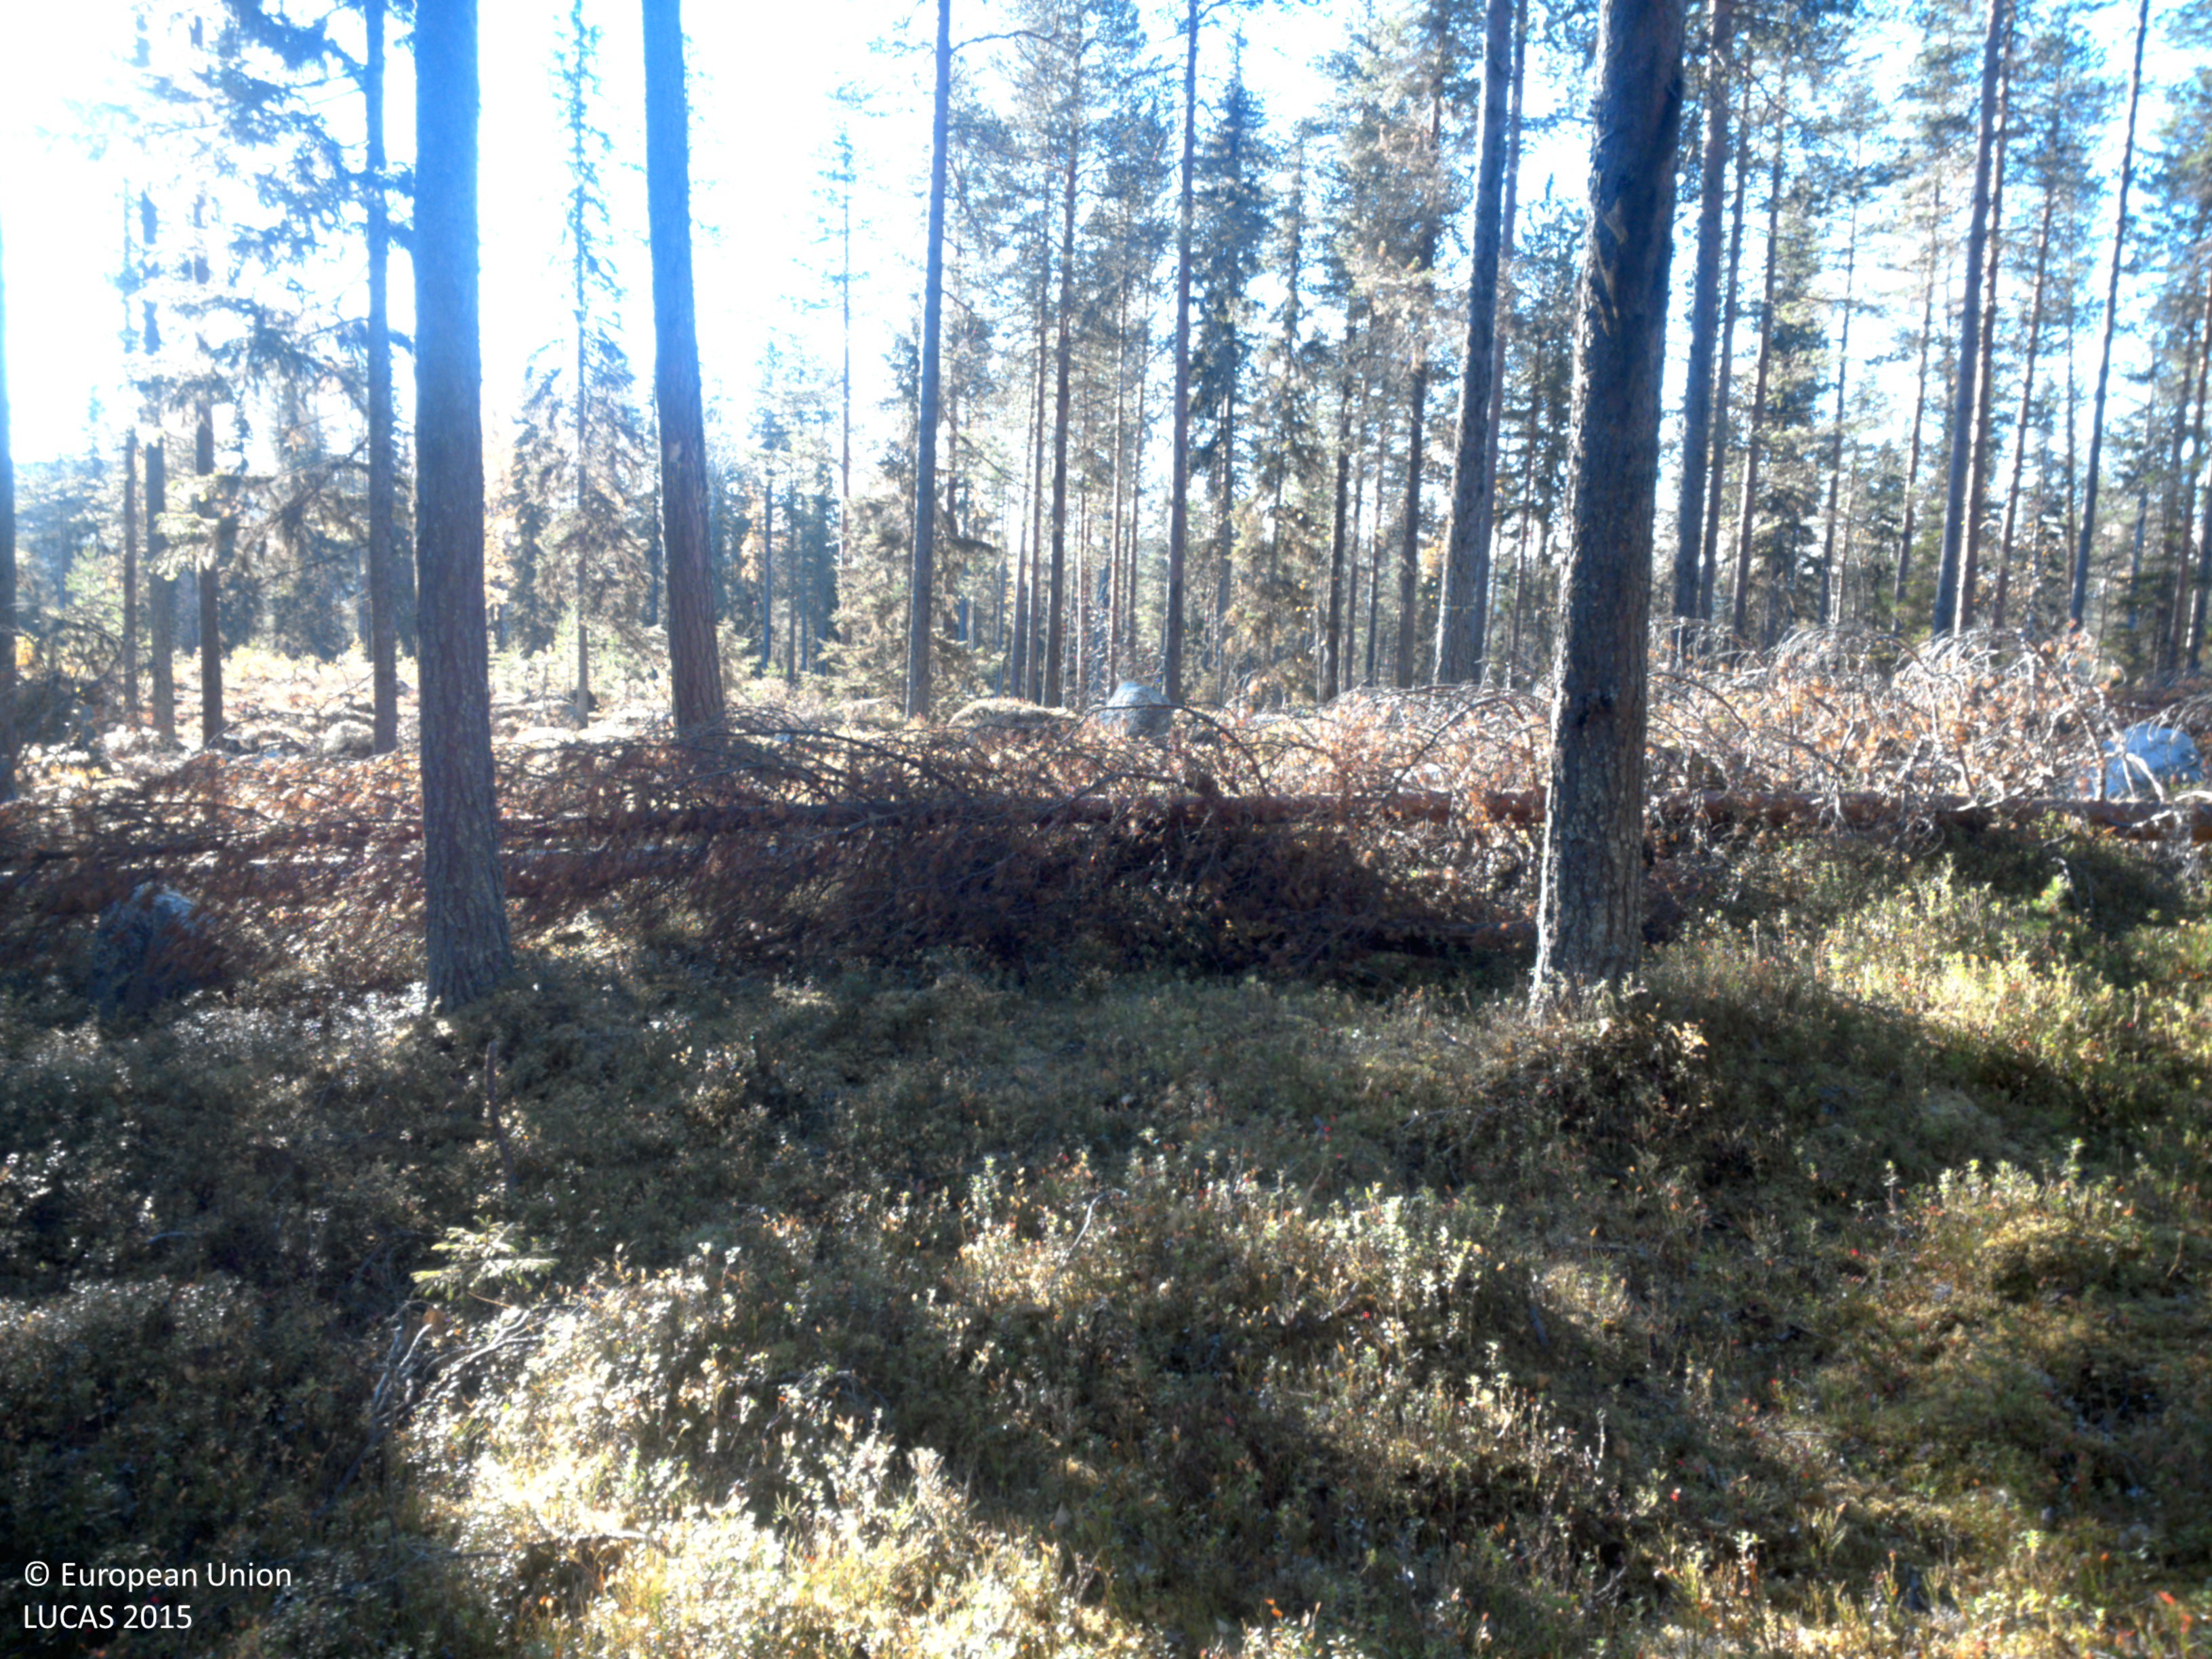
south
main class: Woodland
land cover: Other coniferous woodland
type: boreal forest
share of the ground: 50 - 75 %
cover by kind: coniferous forest trees 65 %, shrubs 20 %, lichens and mosses 10 %, herbaceous plants 5 %
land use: Forestry
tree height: > 5 m
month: October
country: SE
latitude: 64.7618
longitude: 18.3108
